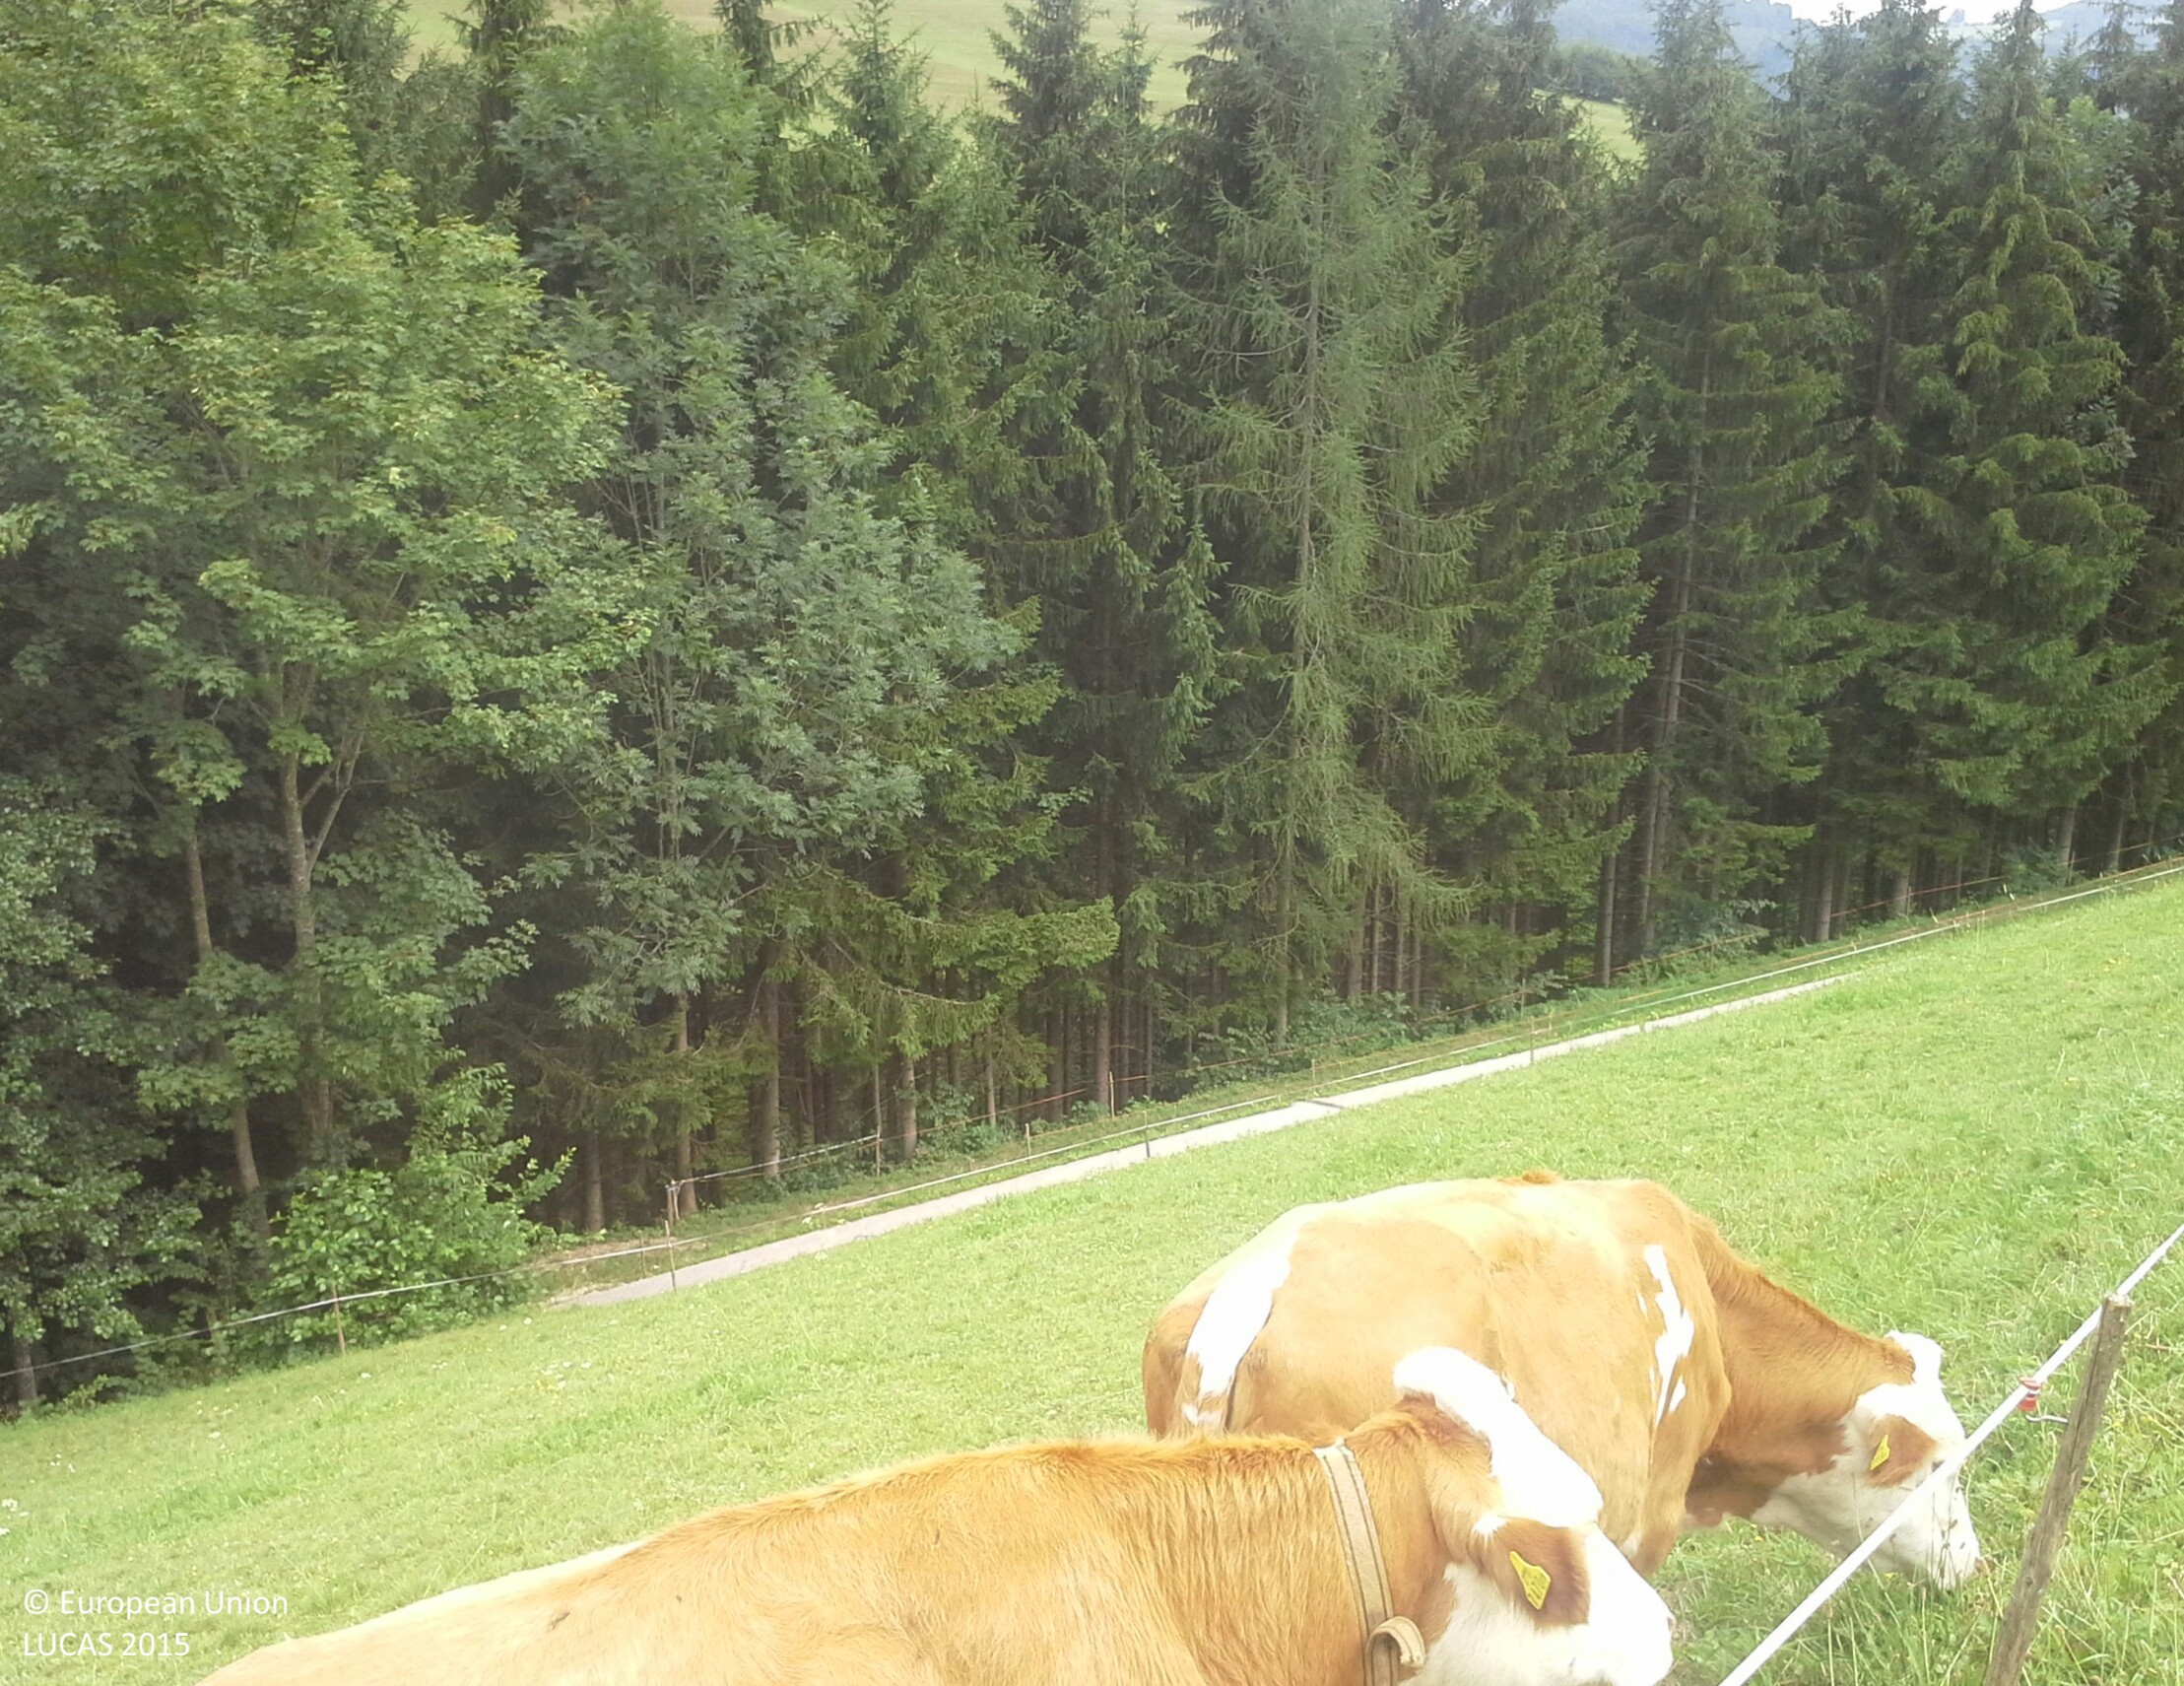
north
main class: Grassland
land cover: Grassland without tree/shrub cover
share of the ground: > 75 %
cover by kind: herbaceous plants 100 %
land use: Agriculture (excluding fallow land and kitchen gardens)
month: July
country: AT
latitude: 48.0187
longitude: 15.0287
